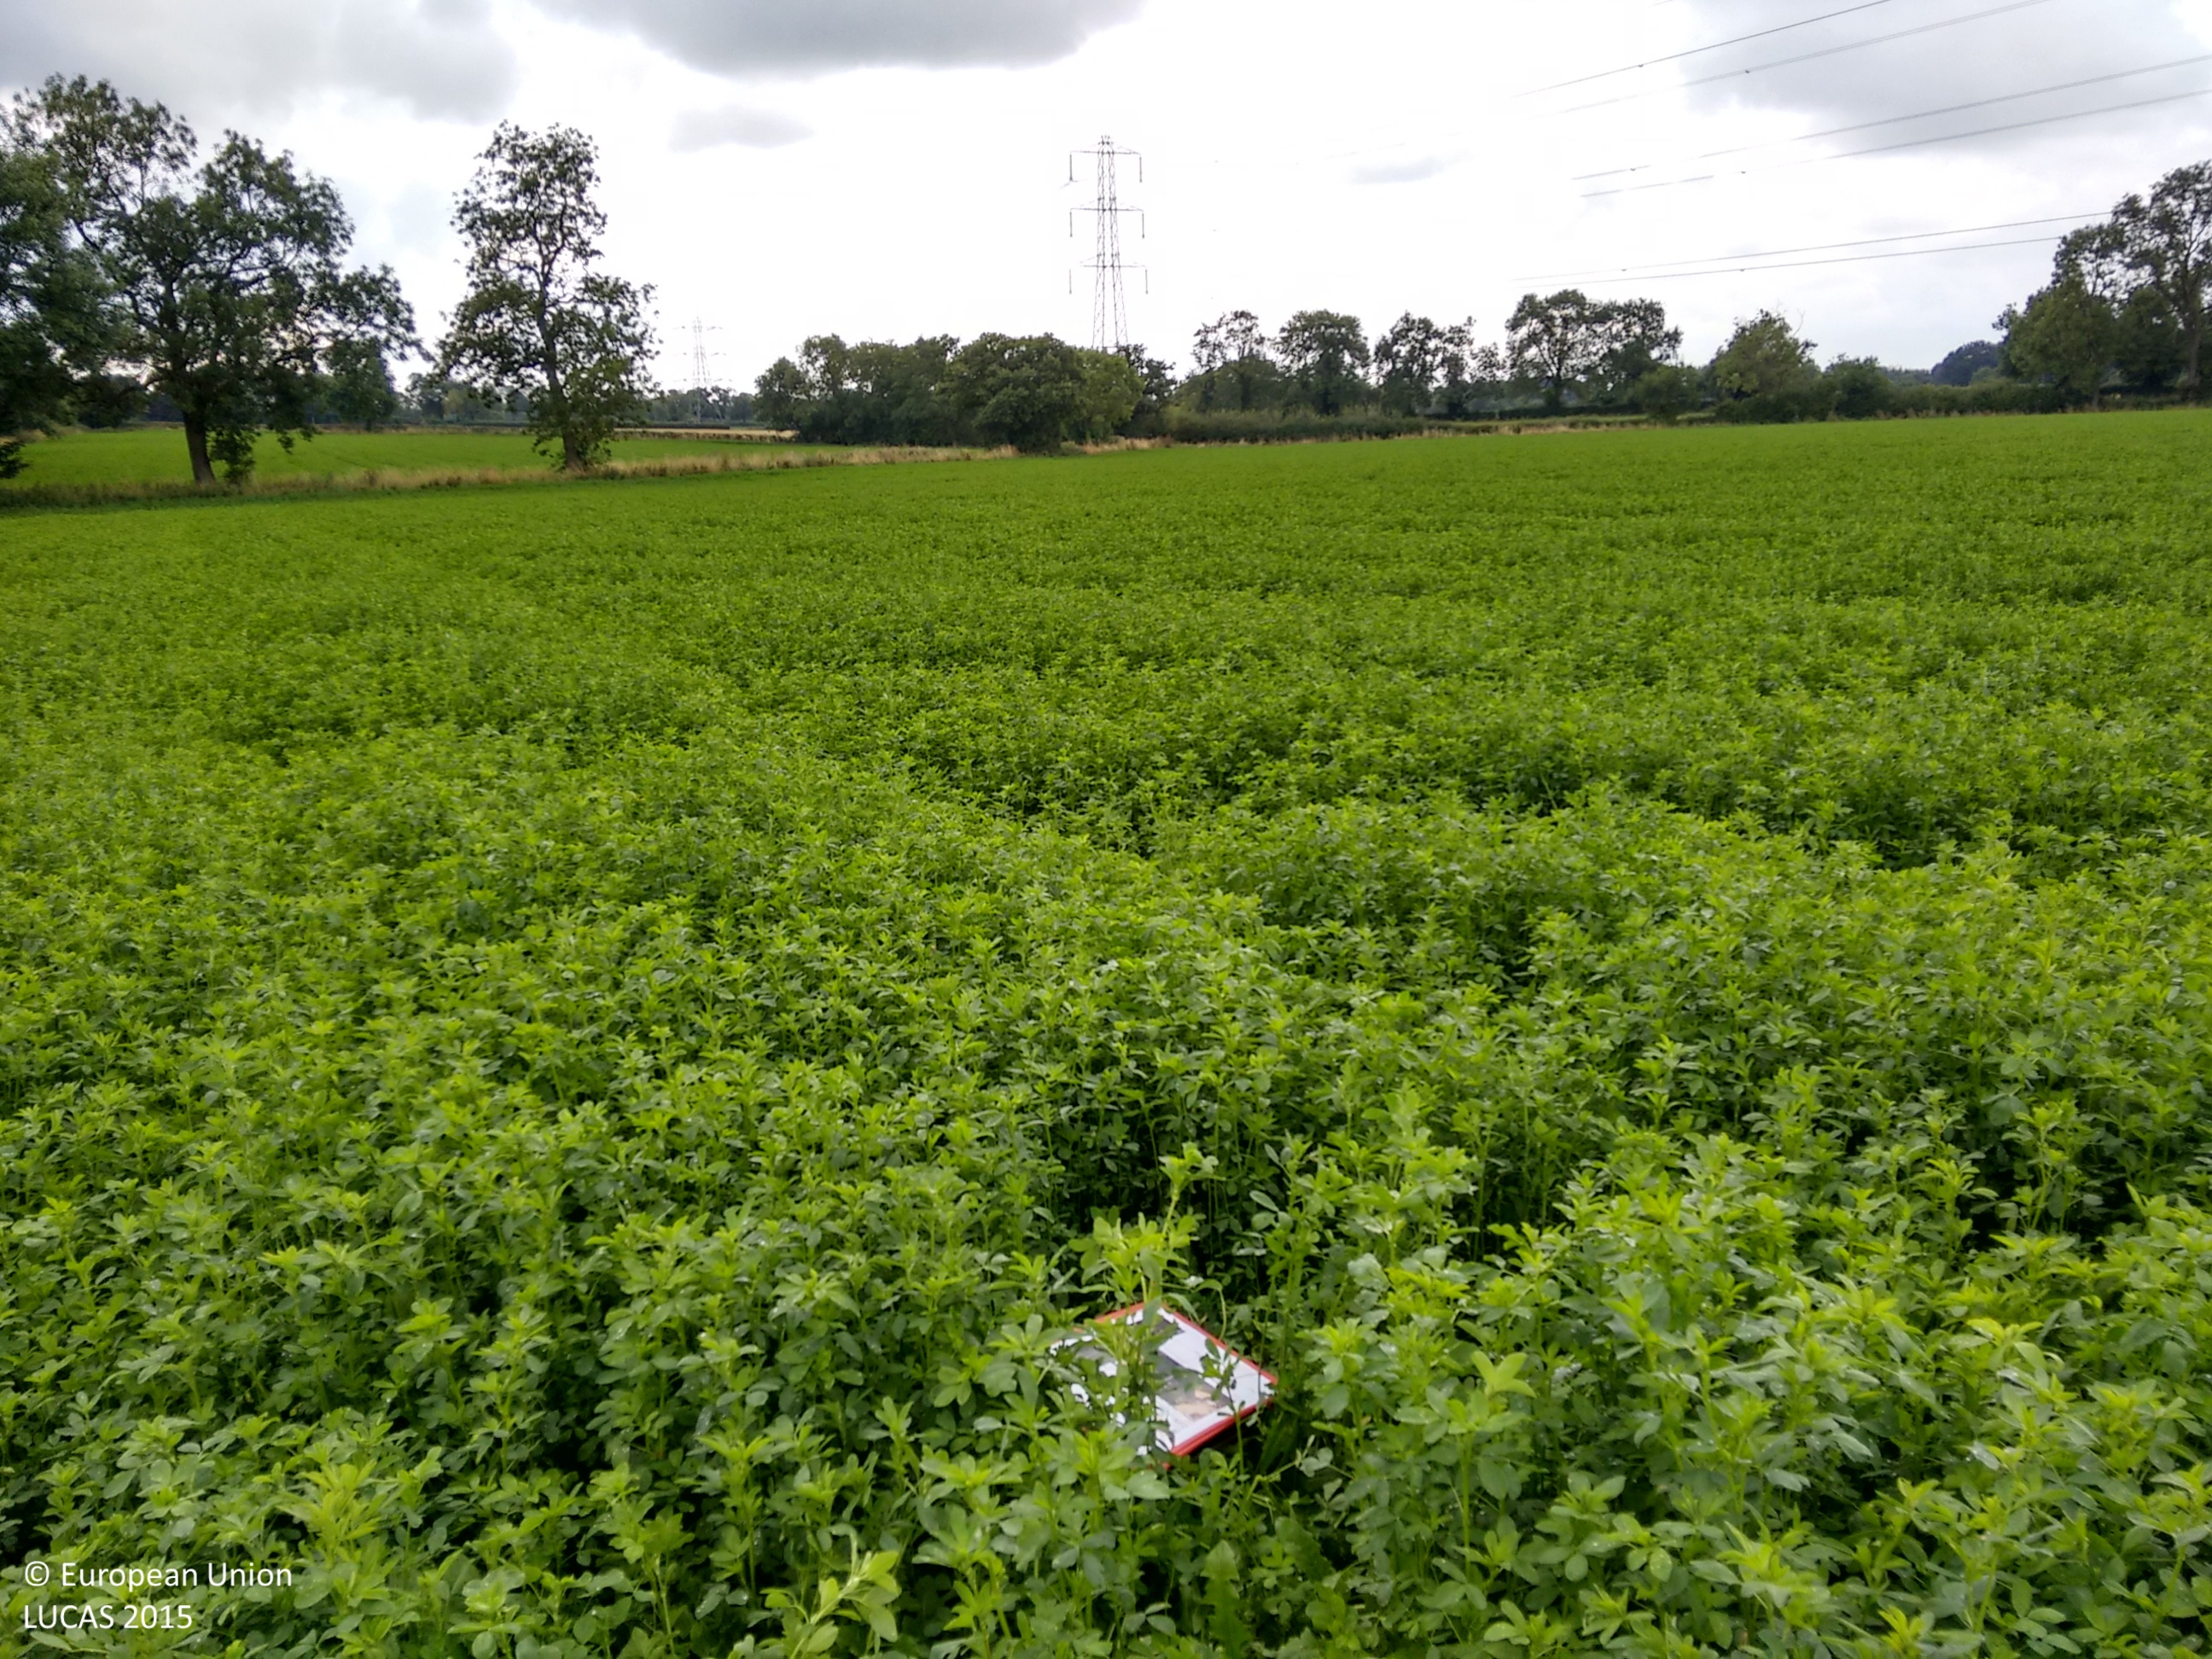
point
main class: Cropland
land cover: Lucerne
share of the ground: > 75 %
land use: Agriculture (excluding fallow land and kitchen gardens)
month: September
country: GB
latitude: 52.4817
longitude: -1.1933
